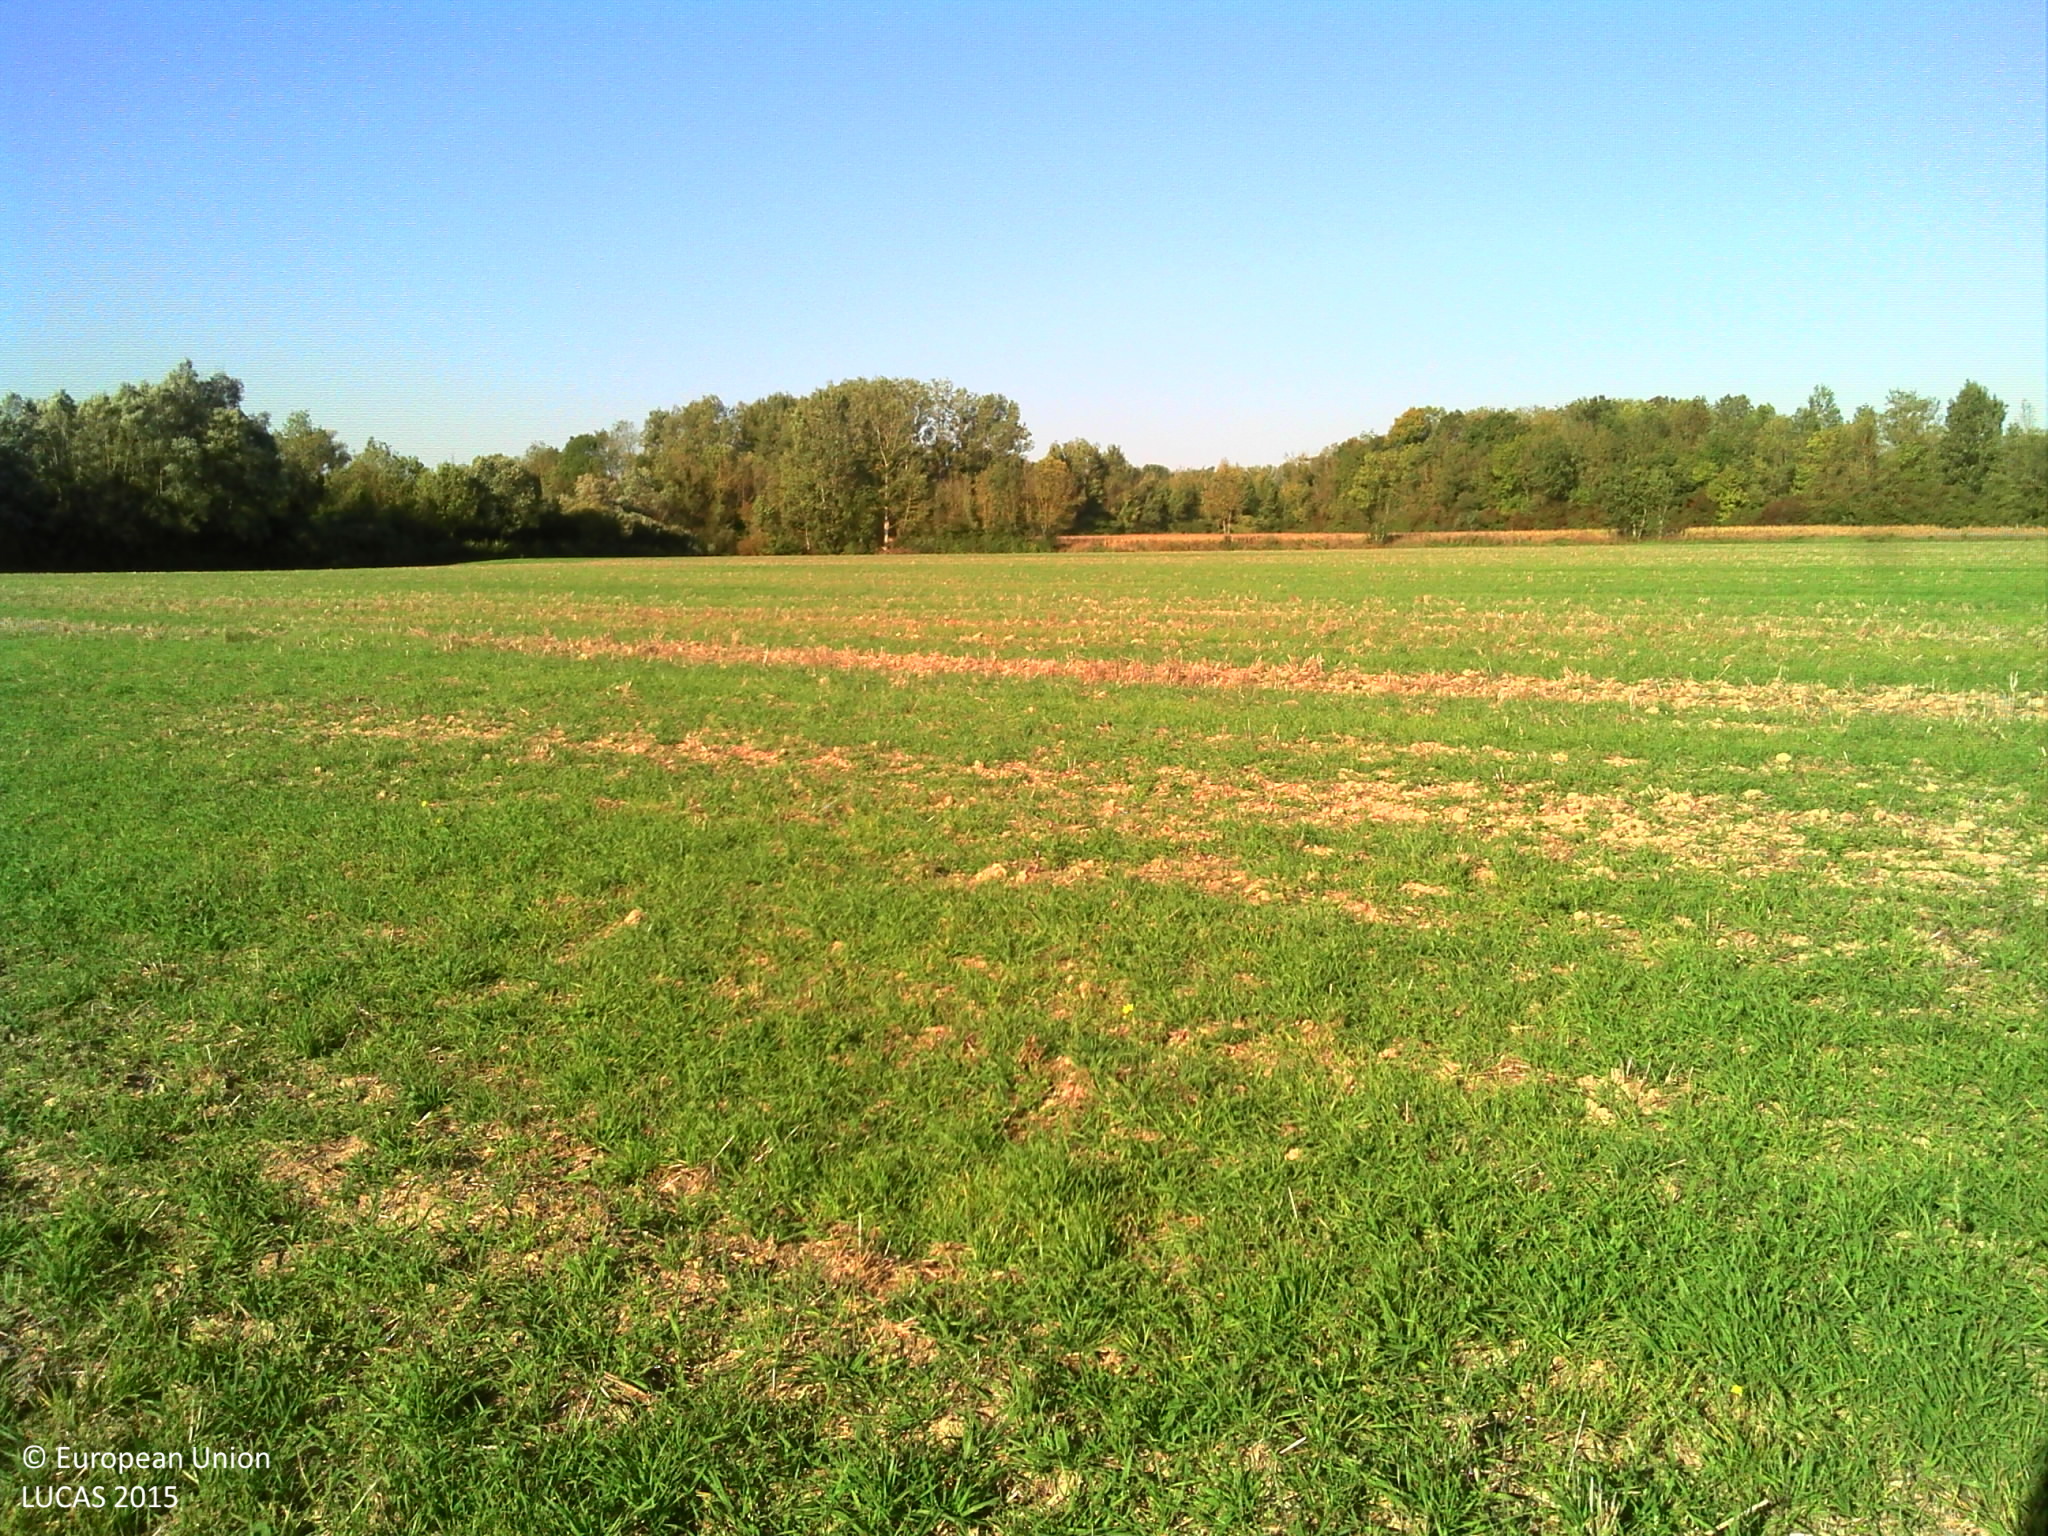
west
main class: Cropland
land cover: Common wheat
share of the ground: < 10 %
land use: Agriculture (excluding fallow land and kitchen gardens)
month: September
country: FR
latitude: 48.4579
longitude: 3.3811
